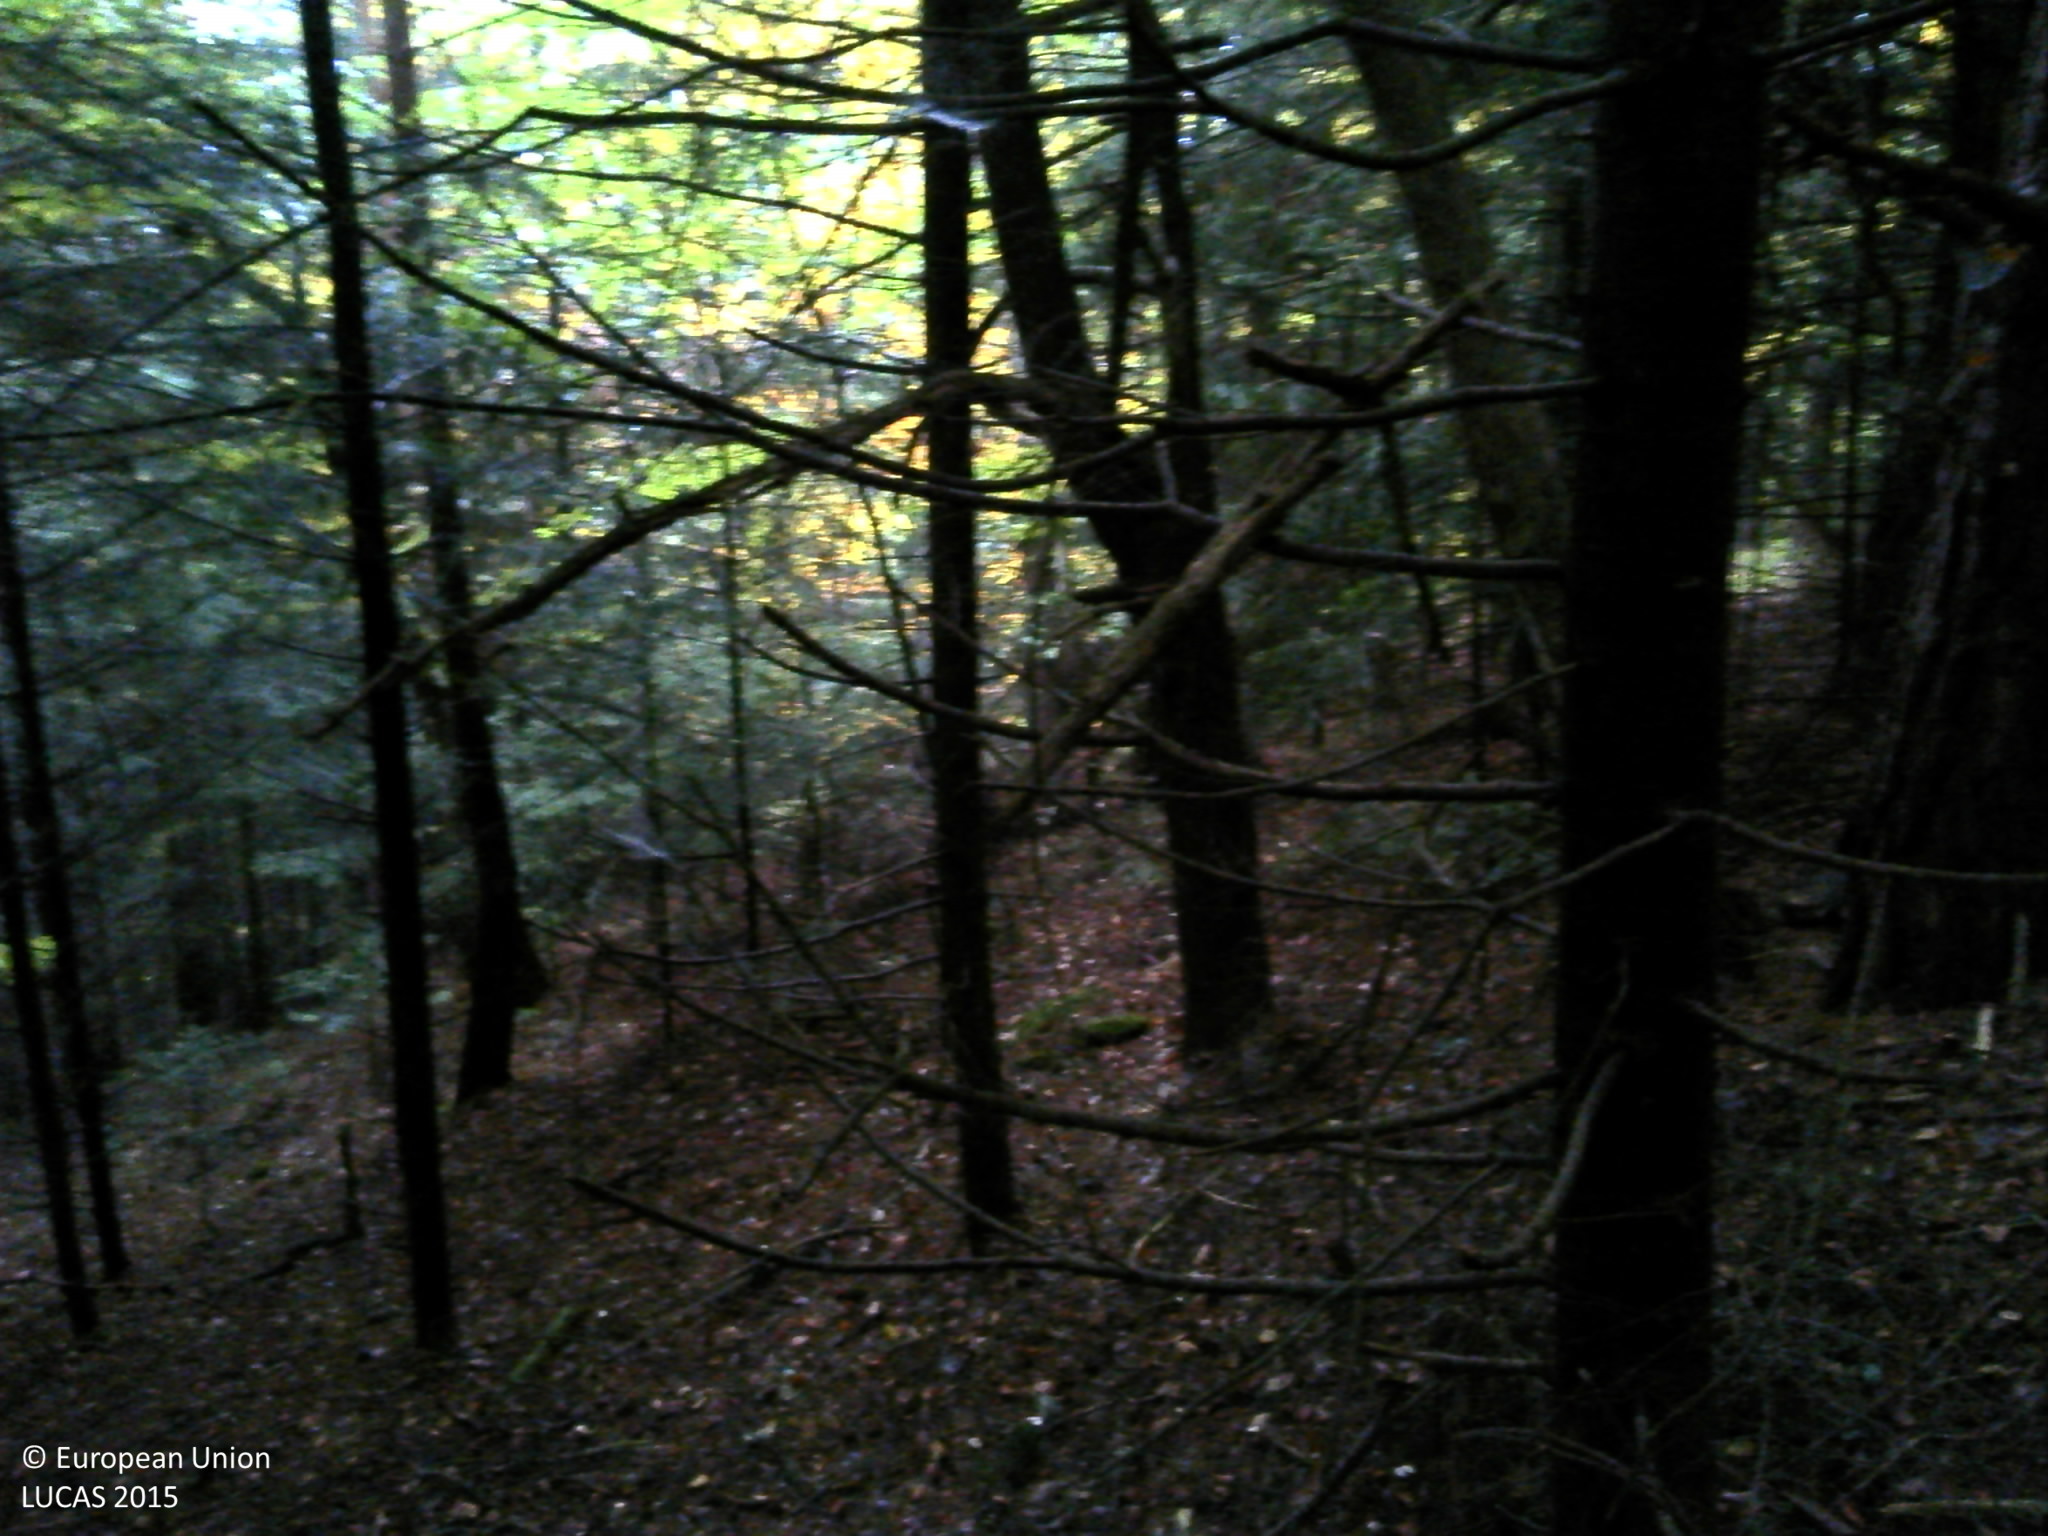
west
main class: Woodland
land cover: Pine dominated mixed woodland
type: mountainous beech forest
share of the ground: > 75 %
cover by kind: coniferous forest trees 50 %, broadleaved forest trees 40 %, unconsolidated bare surface 10 %
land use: Forestry
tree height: > 5 m
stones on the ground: 10 - 25 %
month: October
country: FR
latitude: 45.3754
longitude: 3.7841
